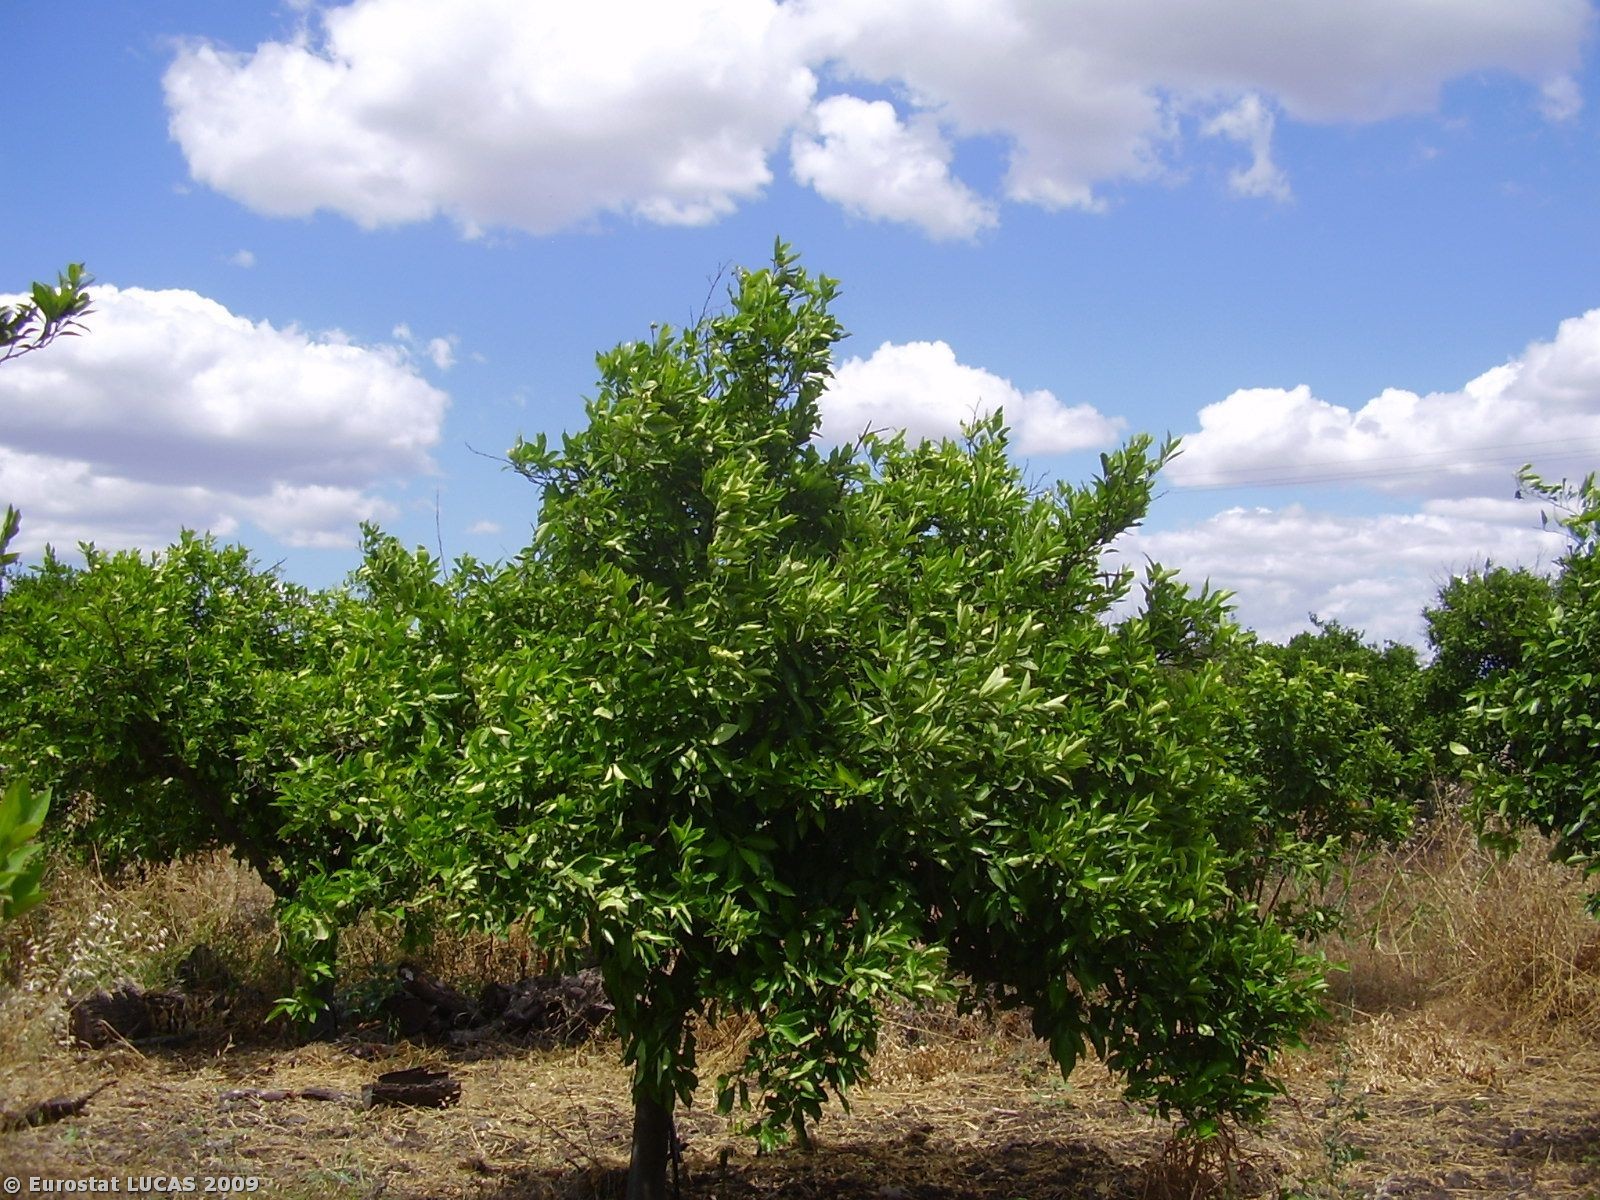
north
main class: Cropland
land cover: Oranges
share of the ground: 50 - 75 %
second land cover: Bare land
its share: > 75 %
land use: Agriculture (excluding fallow land and kitchen gardens)
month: June
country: IT
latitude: 37.2930
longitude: 14.9154
